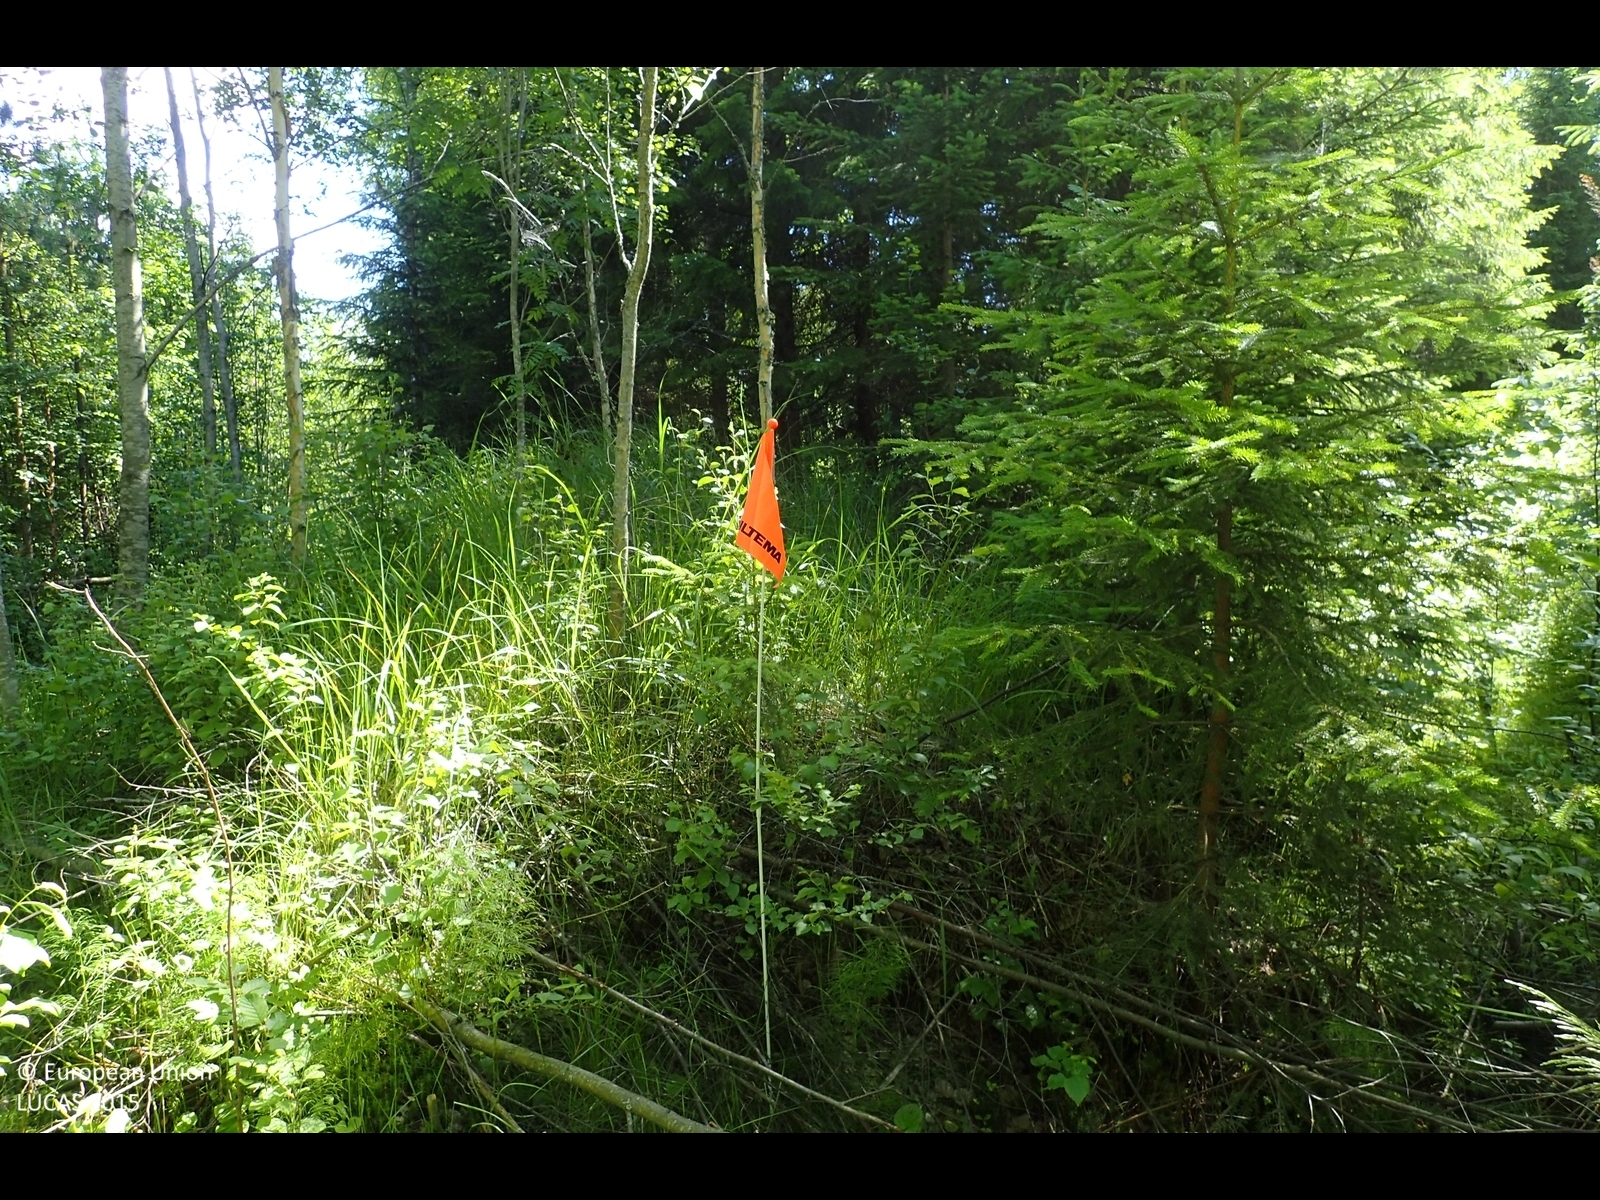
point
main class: Woodland
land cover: Broadleaved woodland
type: boreal forest
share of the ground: > 75 %
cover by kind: broadleaved forest trees 60 %, herbaceous plants 25 %, coniferous forest trees 15 %
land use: Forestry
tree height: > 5 m
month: July
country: FI
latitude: 62.4888
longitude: 21.6298
